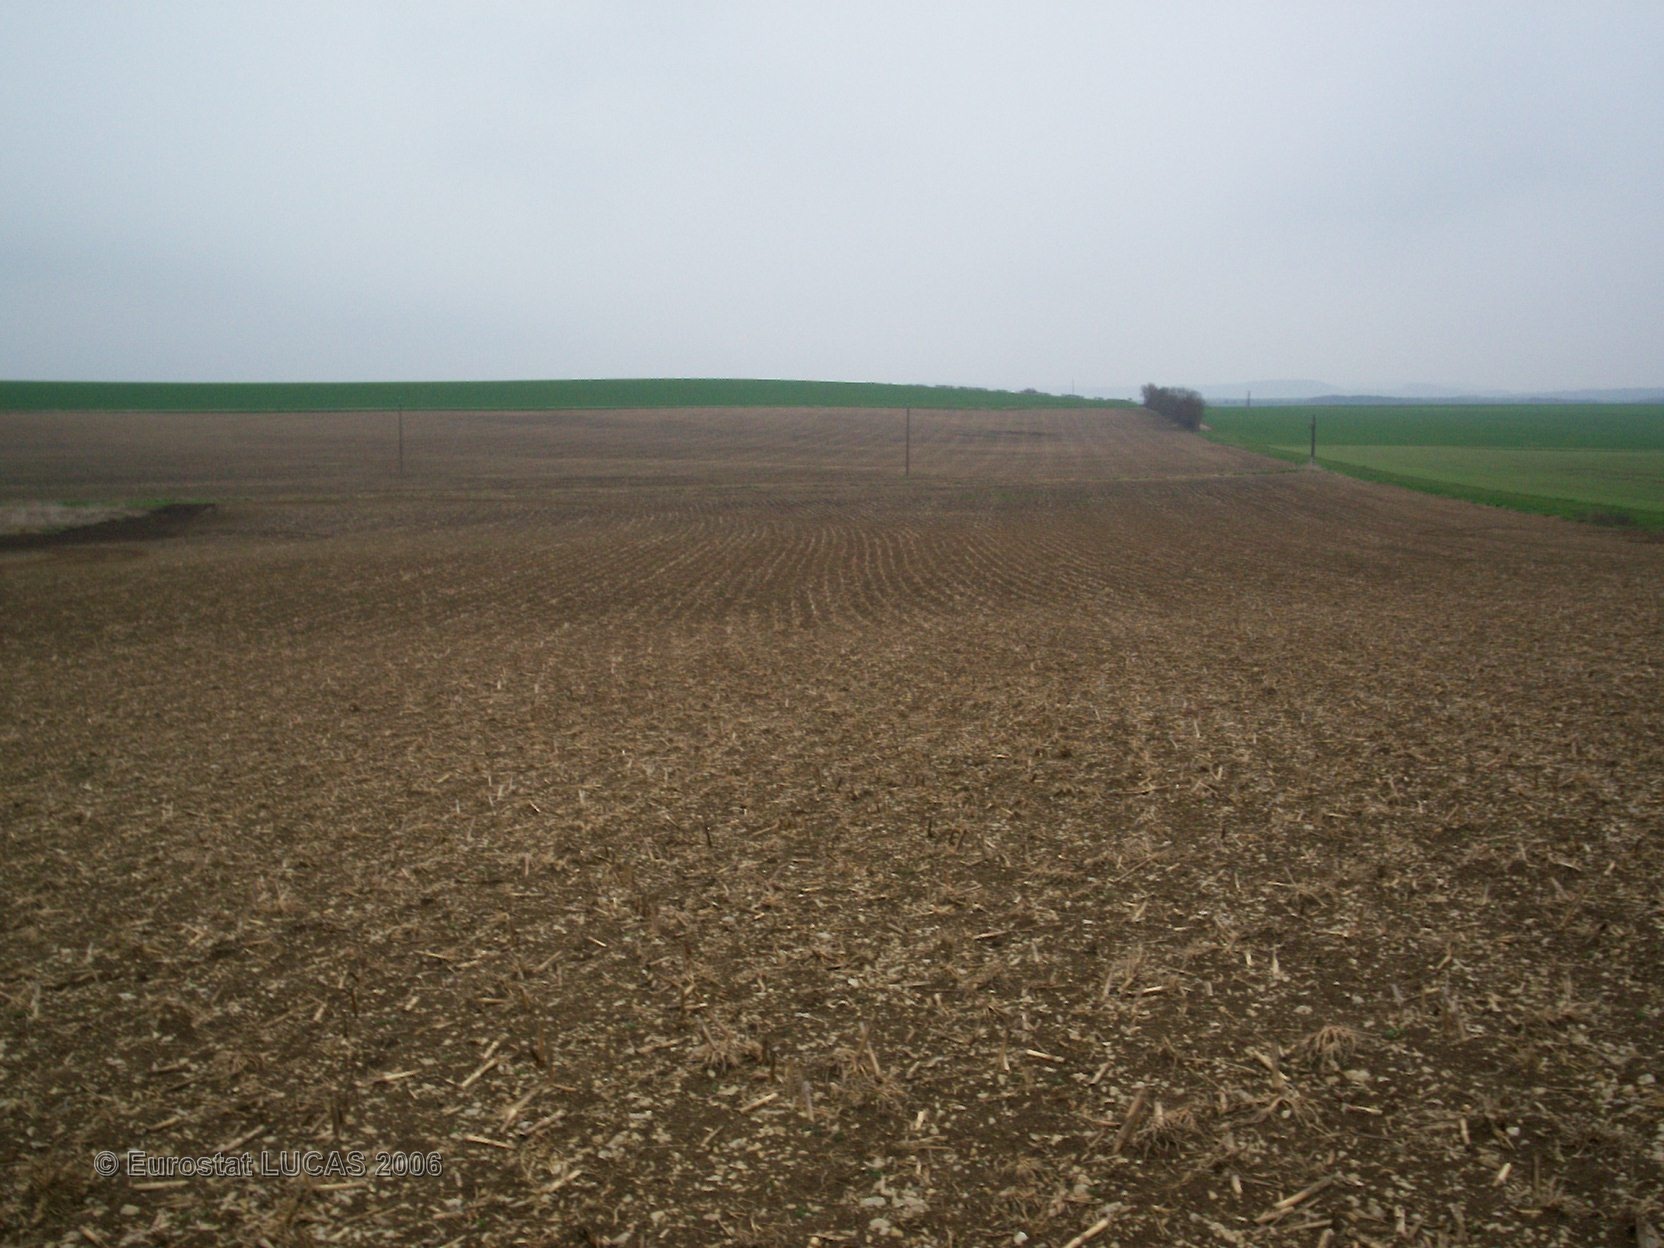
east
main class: Cropland
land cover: Maize
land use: Agriculture (excluding fallow land and kitchen gardens)
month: April
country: FR
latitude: 48.2316
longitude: 4.8962
